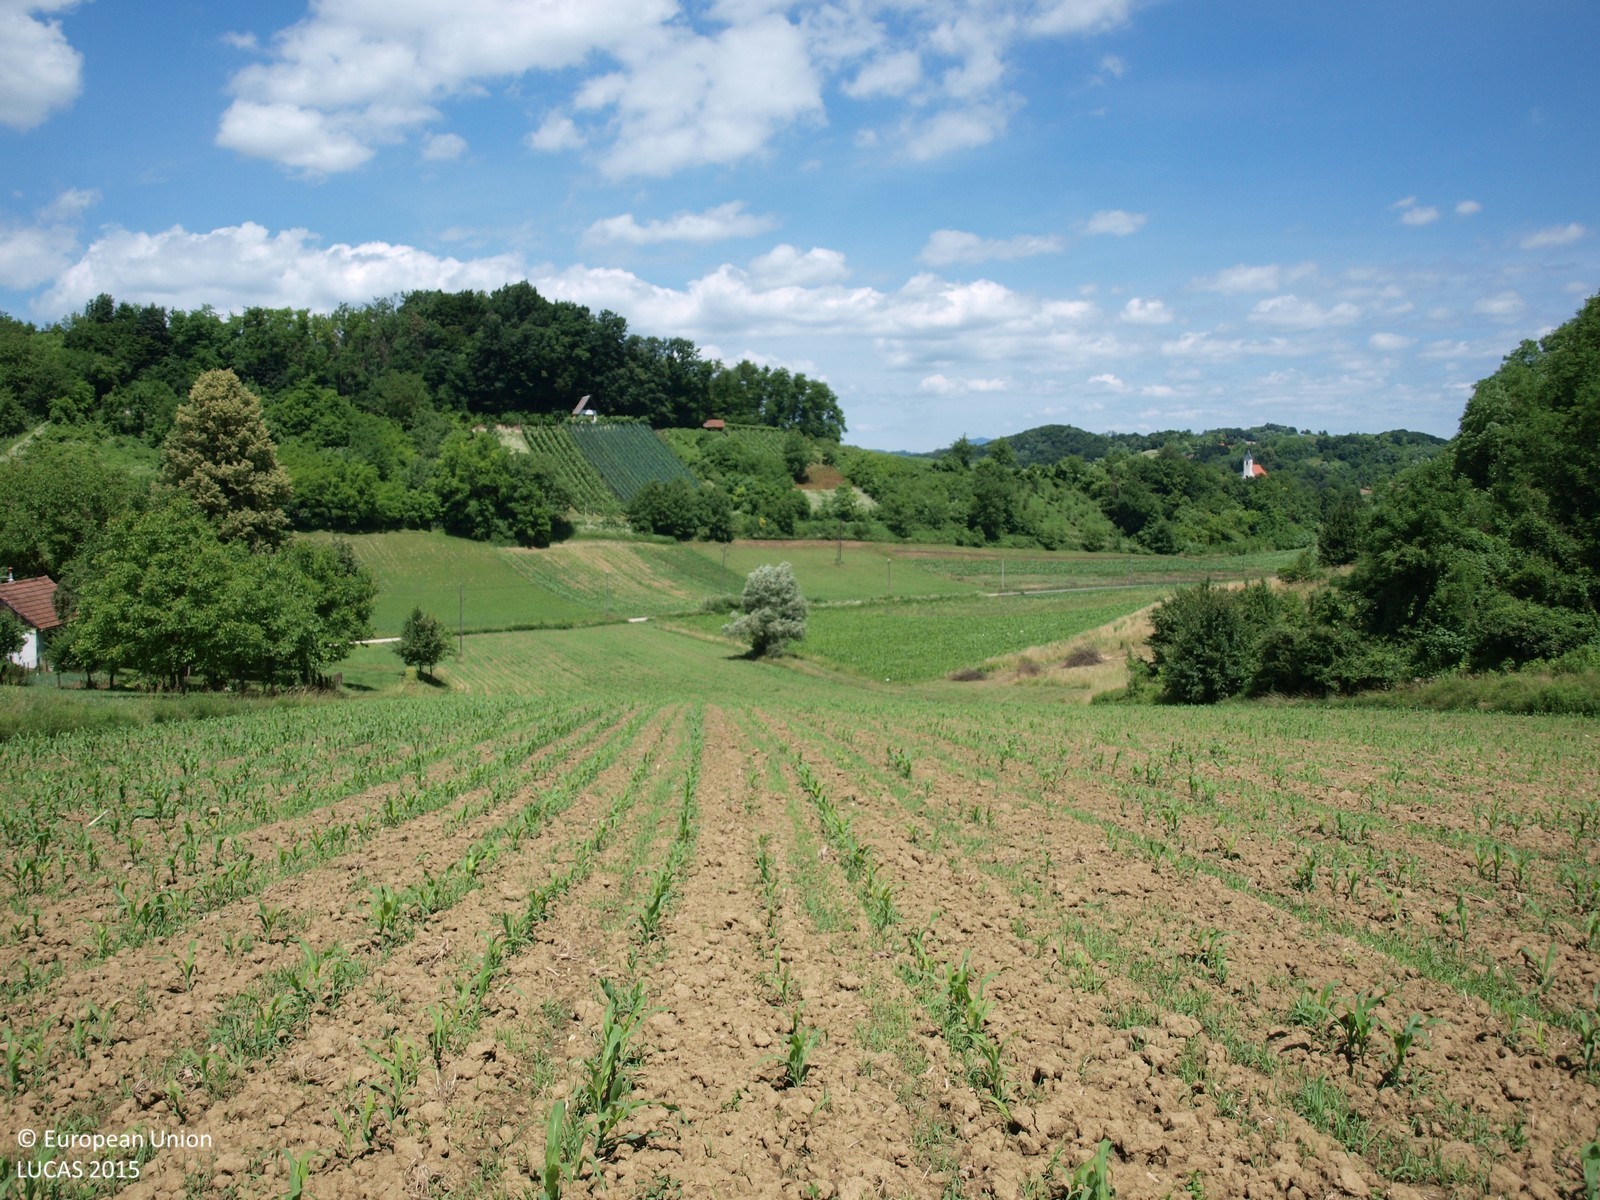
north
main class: Cropland
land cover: Maize
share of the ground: 25 - 50 %
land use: Agriculture (excluding fallow land and kitchen gardens)
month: June
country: HR
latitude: 46.0908
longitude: 15.7018
